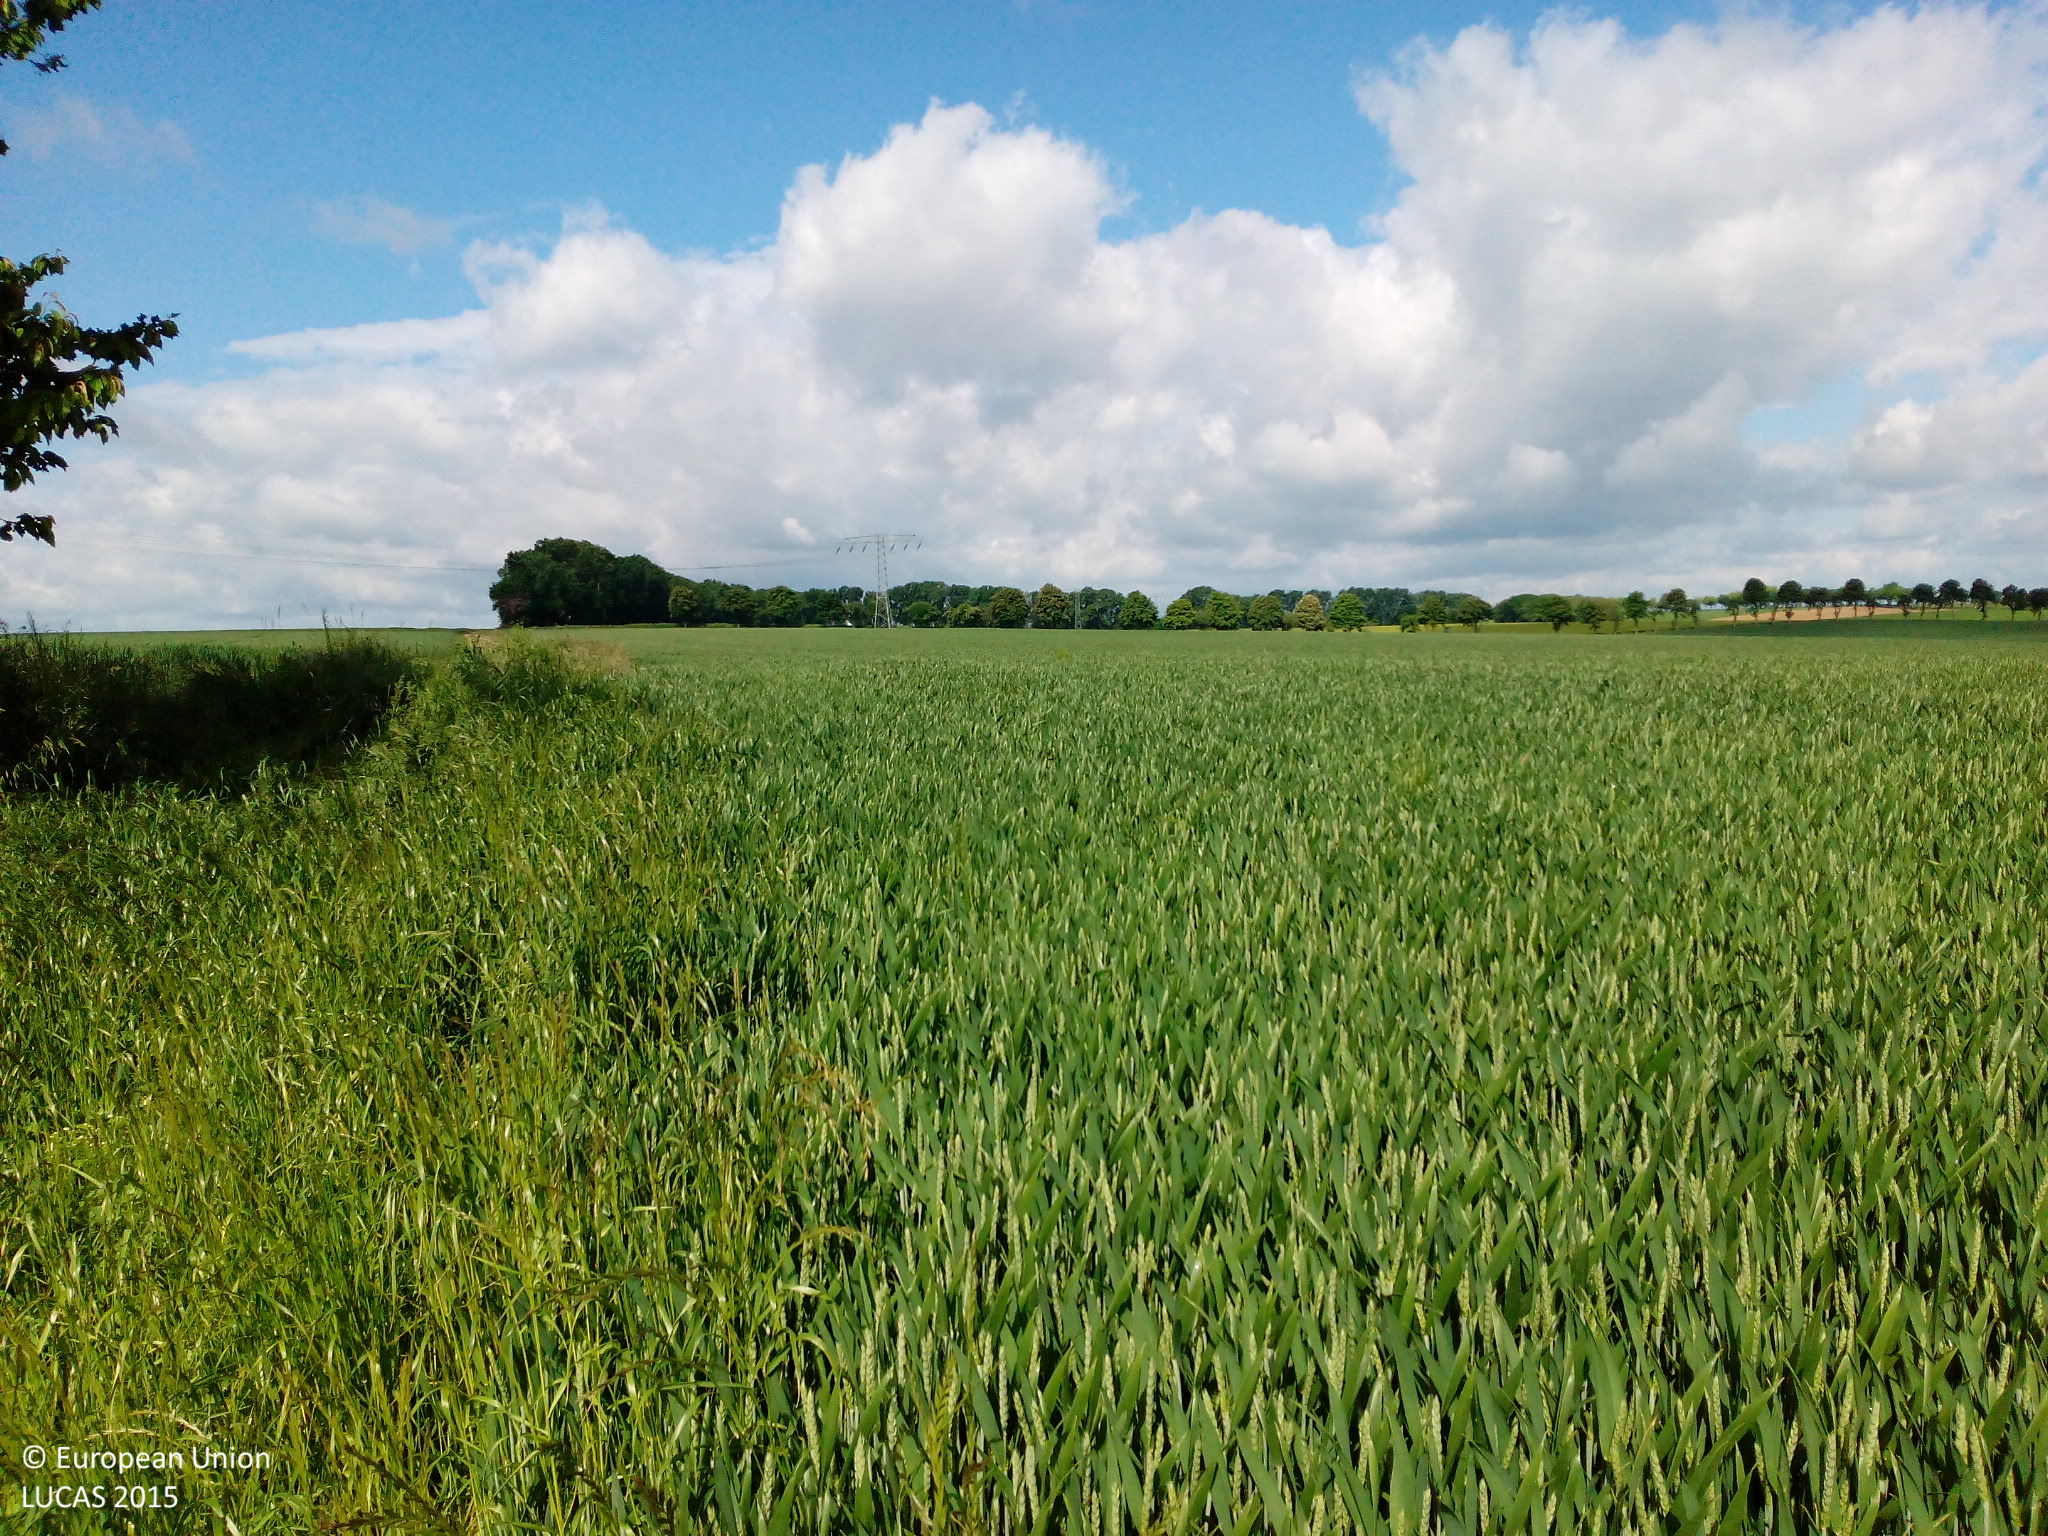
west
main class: Cropland
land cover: Common wheat
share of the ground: > 75 %
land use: Agriculture (excluding fallow land and kitchen gardens)
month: May
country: DE
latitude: 50.9875
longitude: 12.3503
